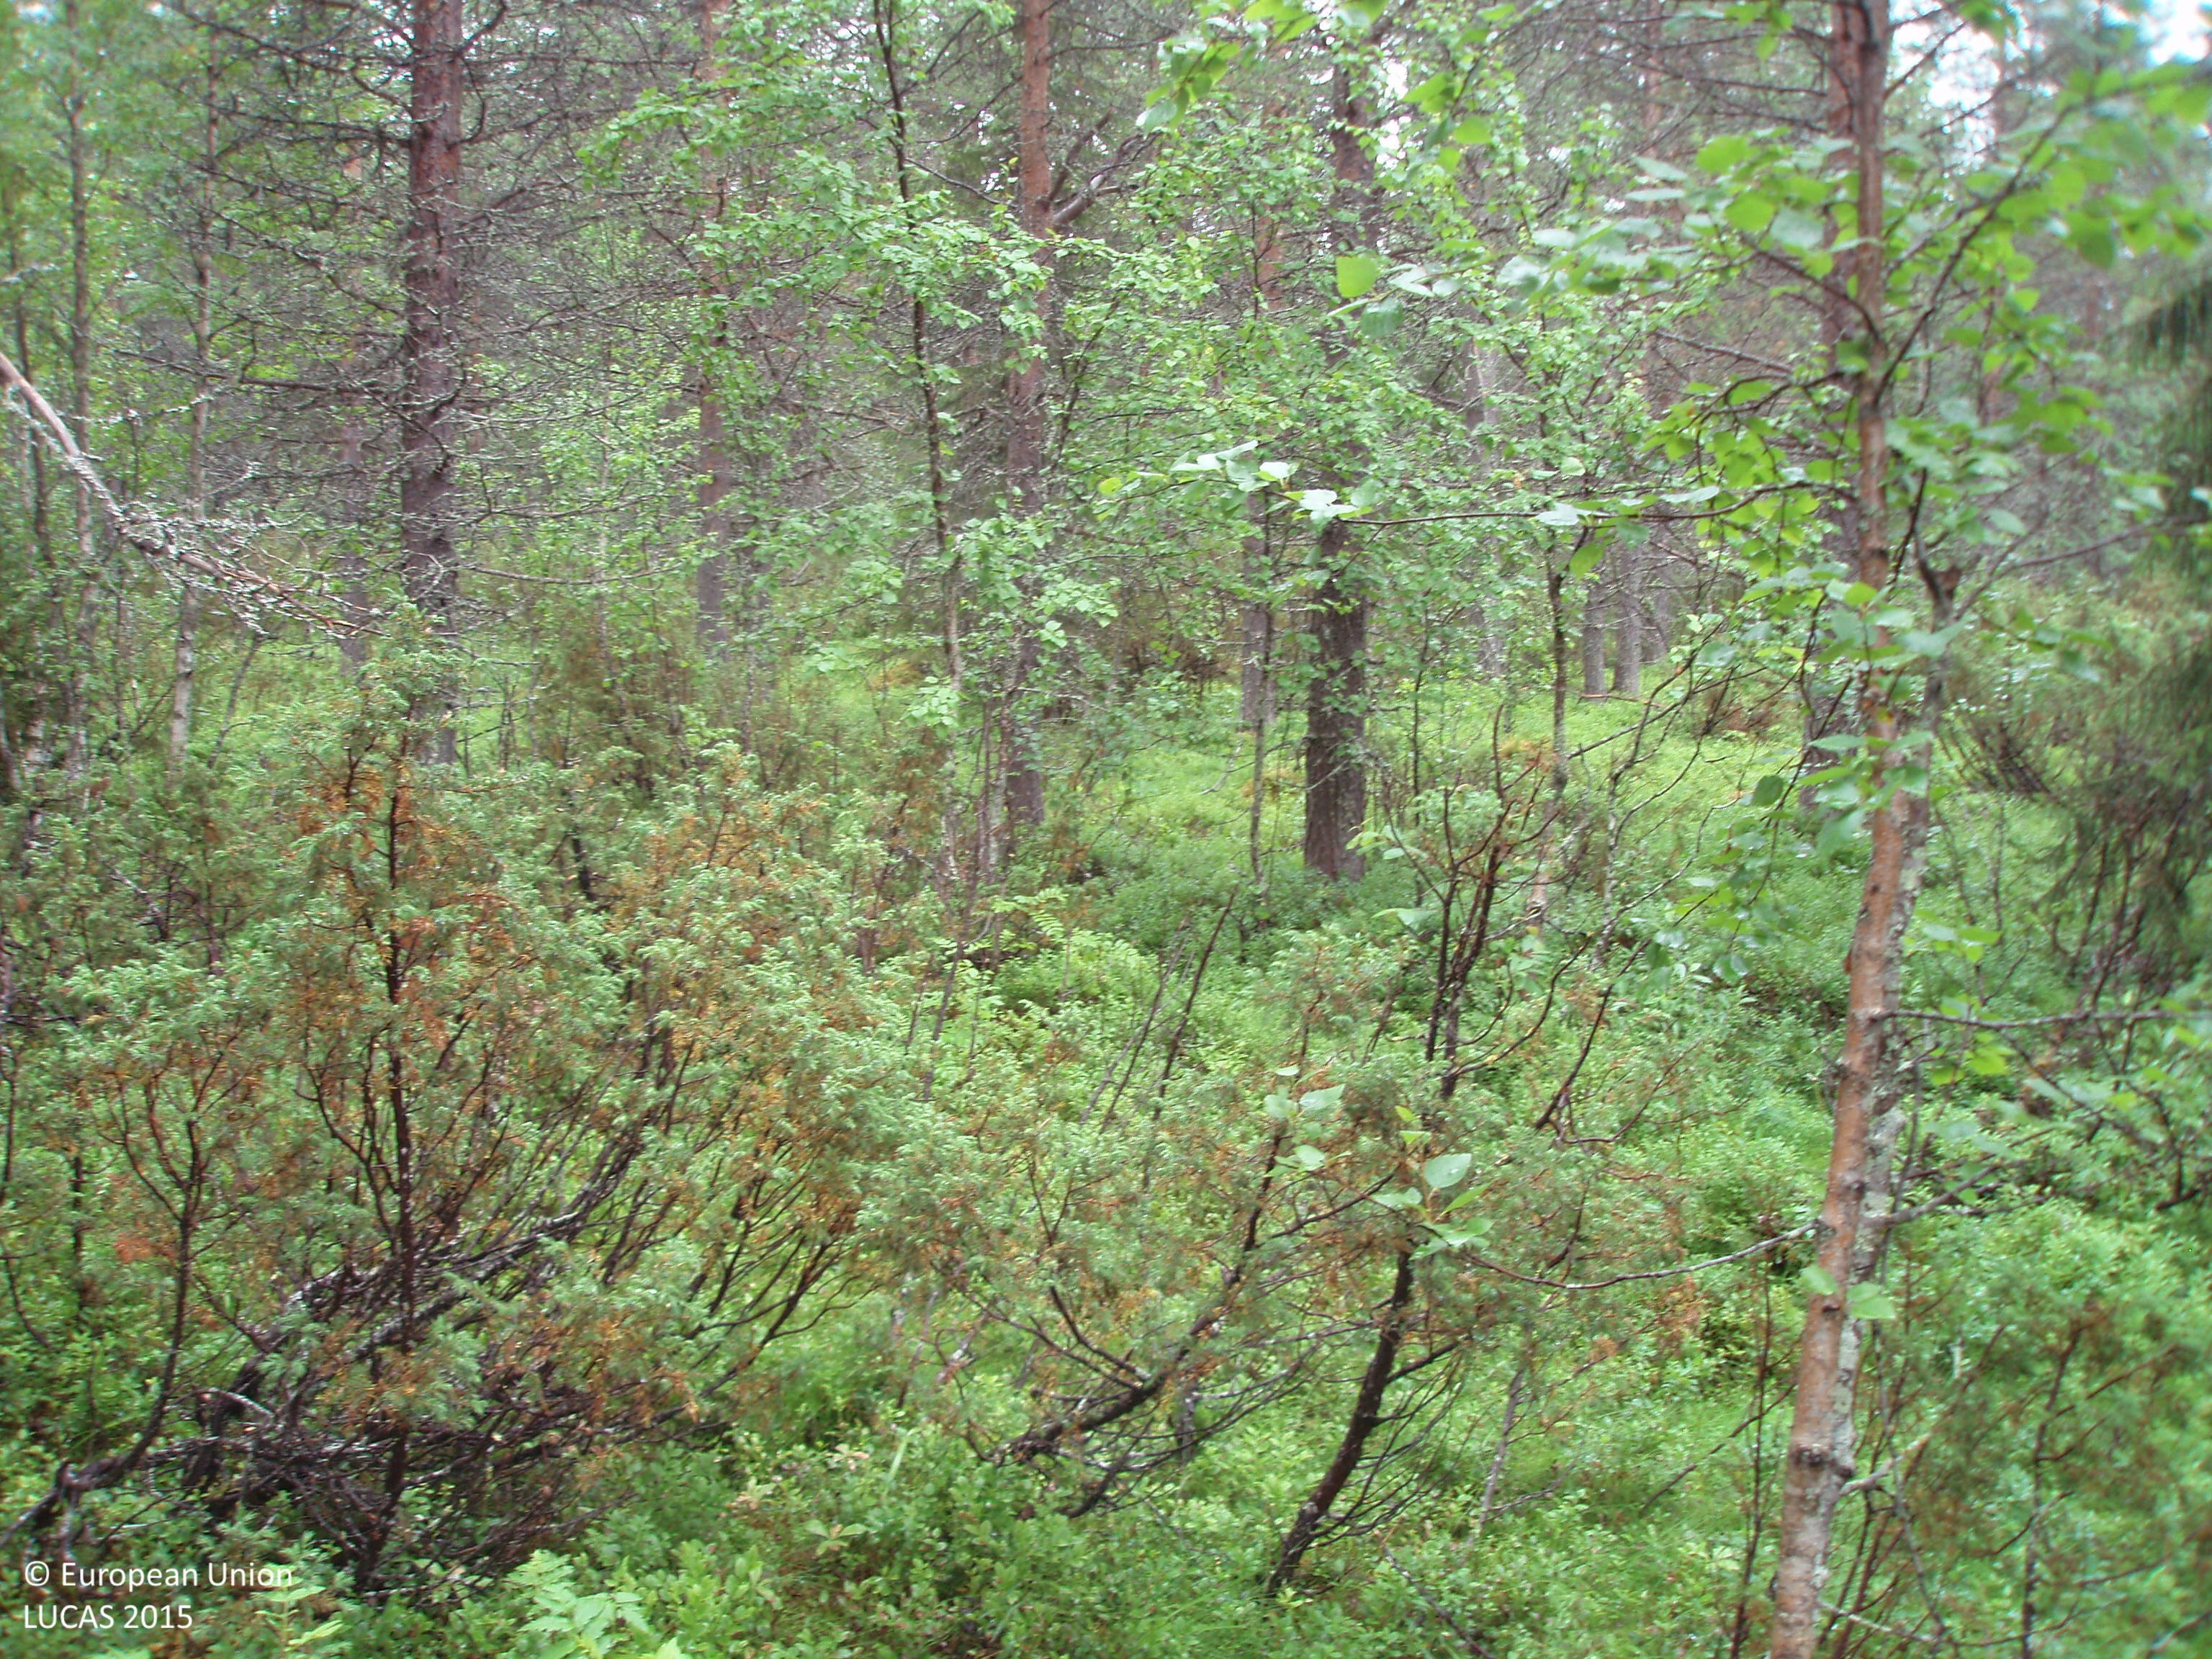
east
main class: Woodland
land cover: Pine dominated mixed woodland
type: boreal forest
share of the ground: > 75 %
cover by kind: coniferous forest trees 55 %, broadleaved forest trees 25 %, shrubs 20 %
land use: Forestry
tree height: > 5 m
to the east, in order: Pine dominated mixed woodland; Ditches and canals; Tracks; Ditches and canals; Pine dominated mixed woodland; Ditches and canals; Pine dominated mixed woodland; Other mixed woodland
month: August
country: FI
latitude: 65.6316
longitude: 27.4816
